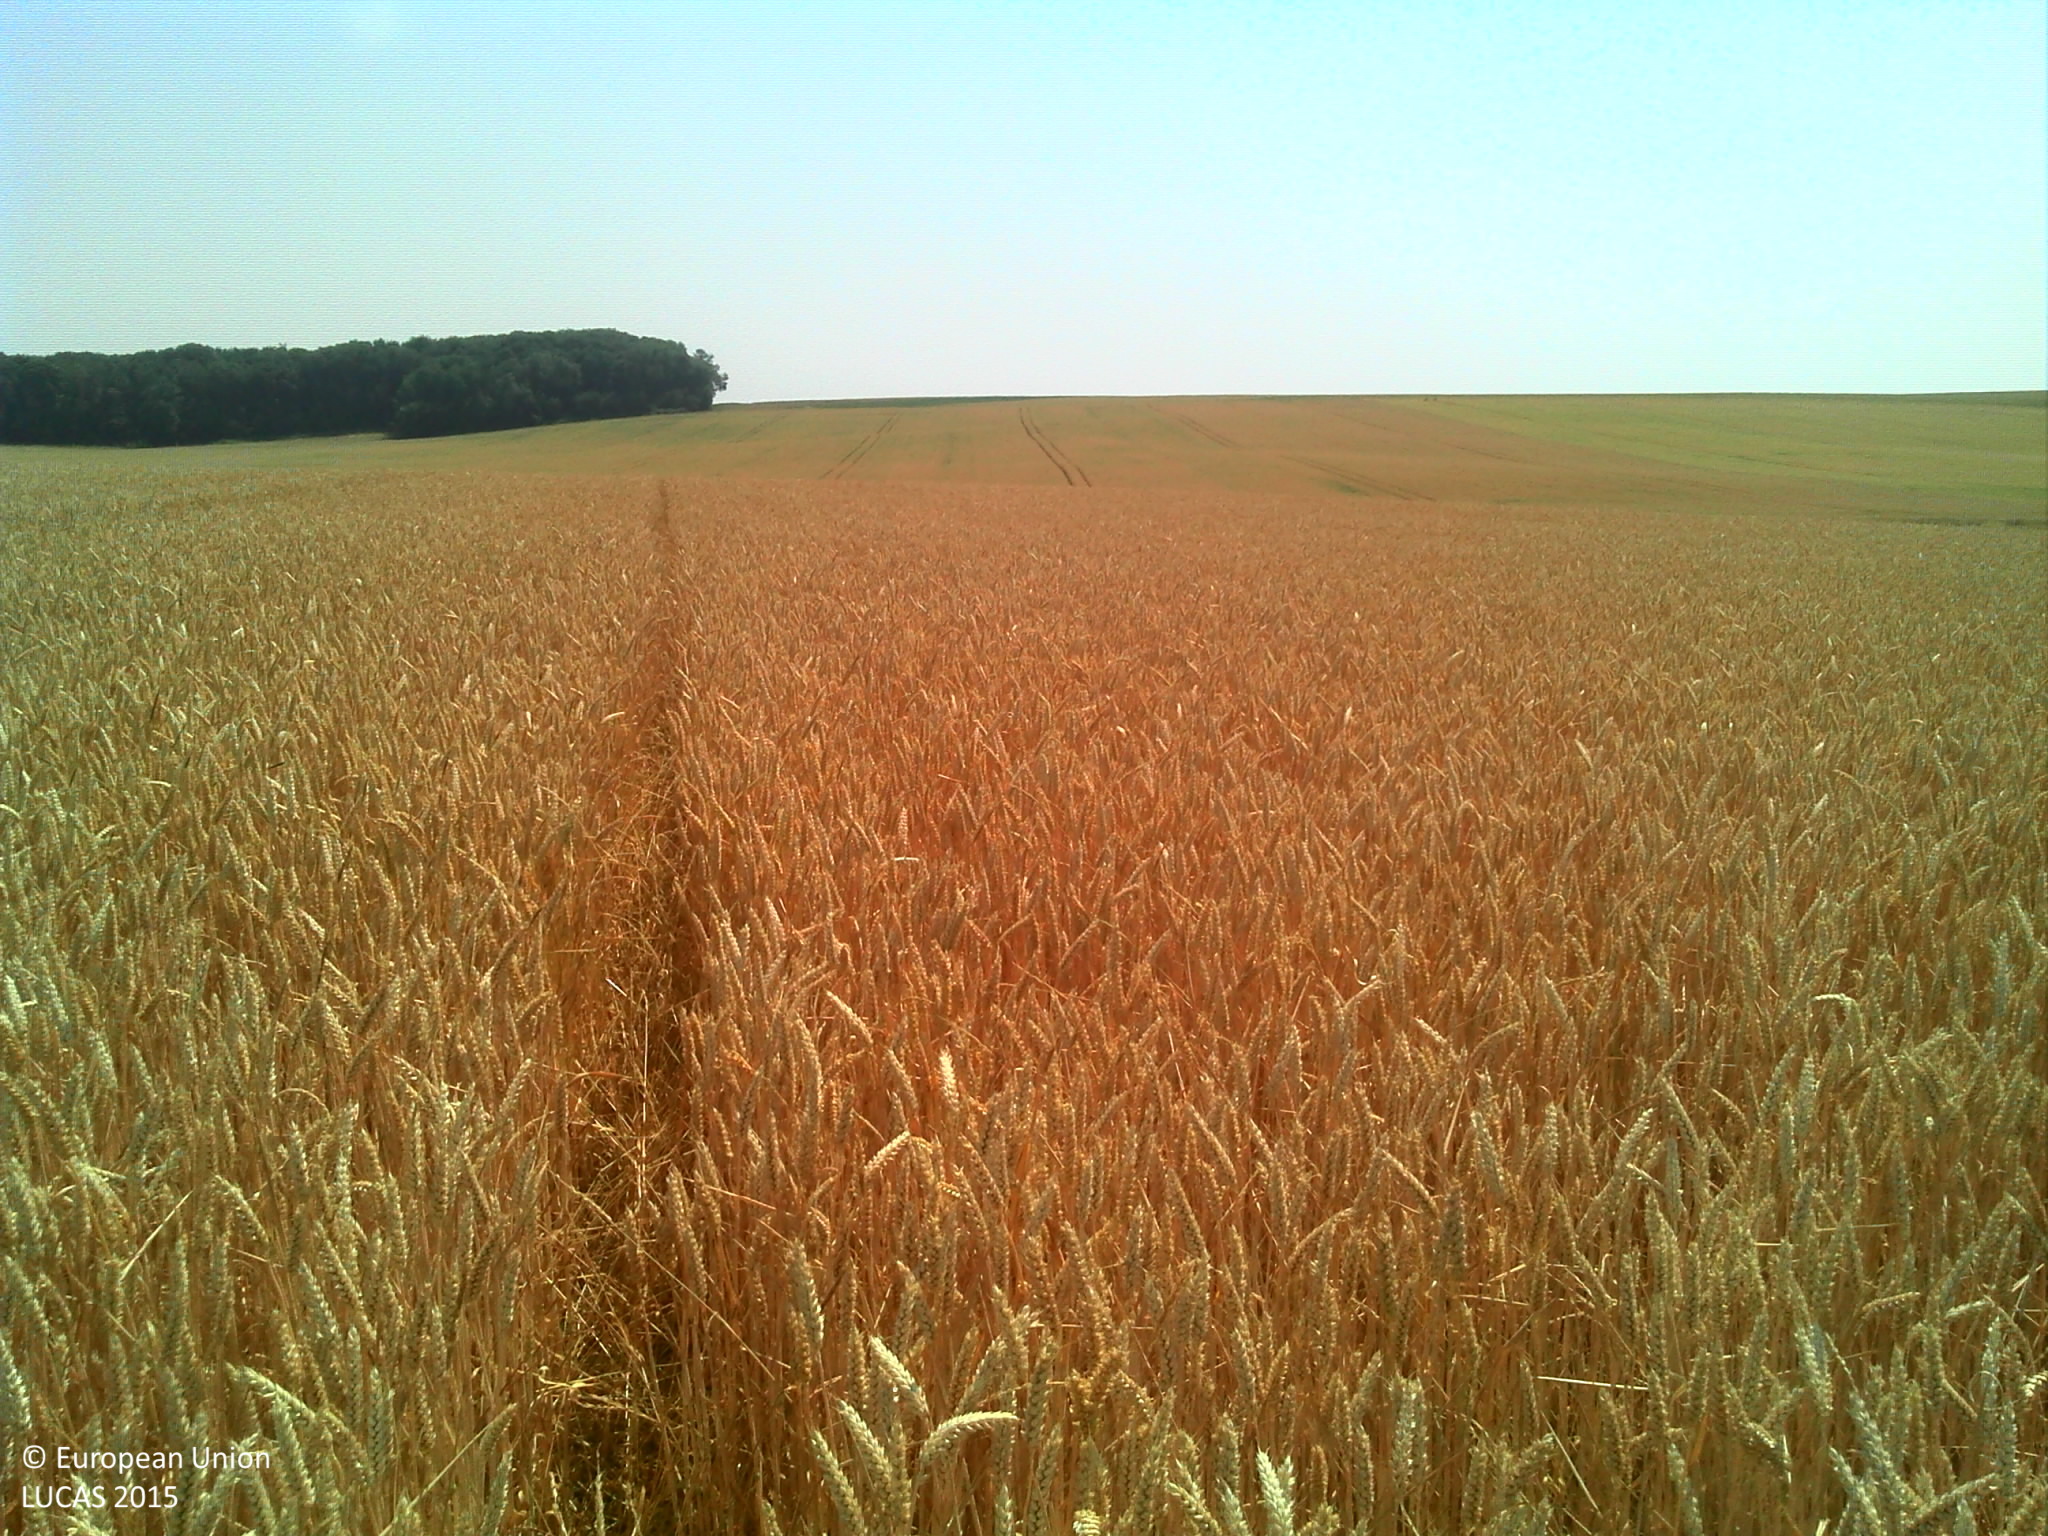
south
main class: Cropland
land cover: Common wheat
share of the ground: > 75 %
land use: Agriculture (excluding fallow land and kitchen gardens)
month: July
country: FR
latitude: 49.1562
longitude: 3.2871
